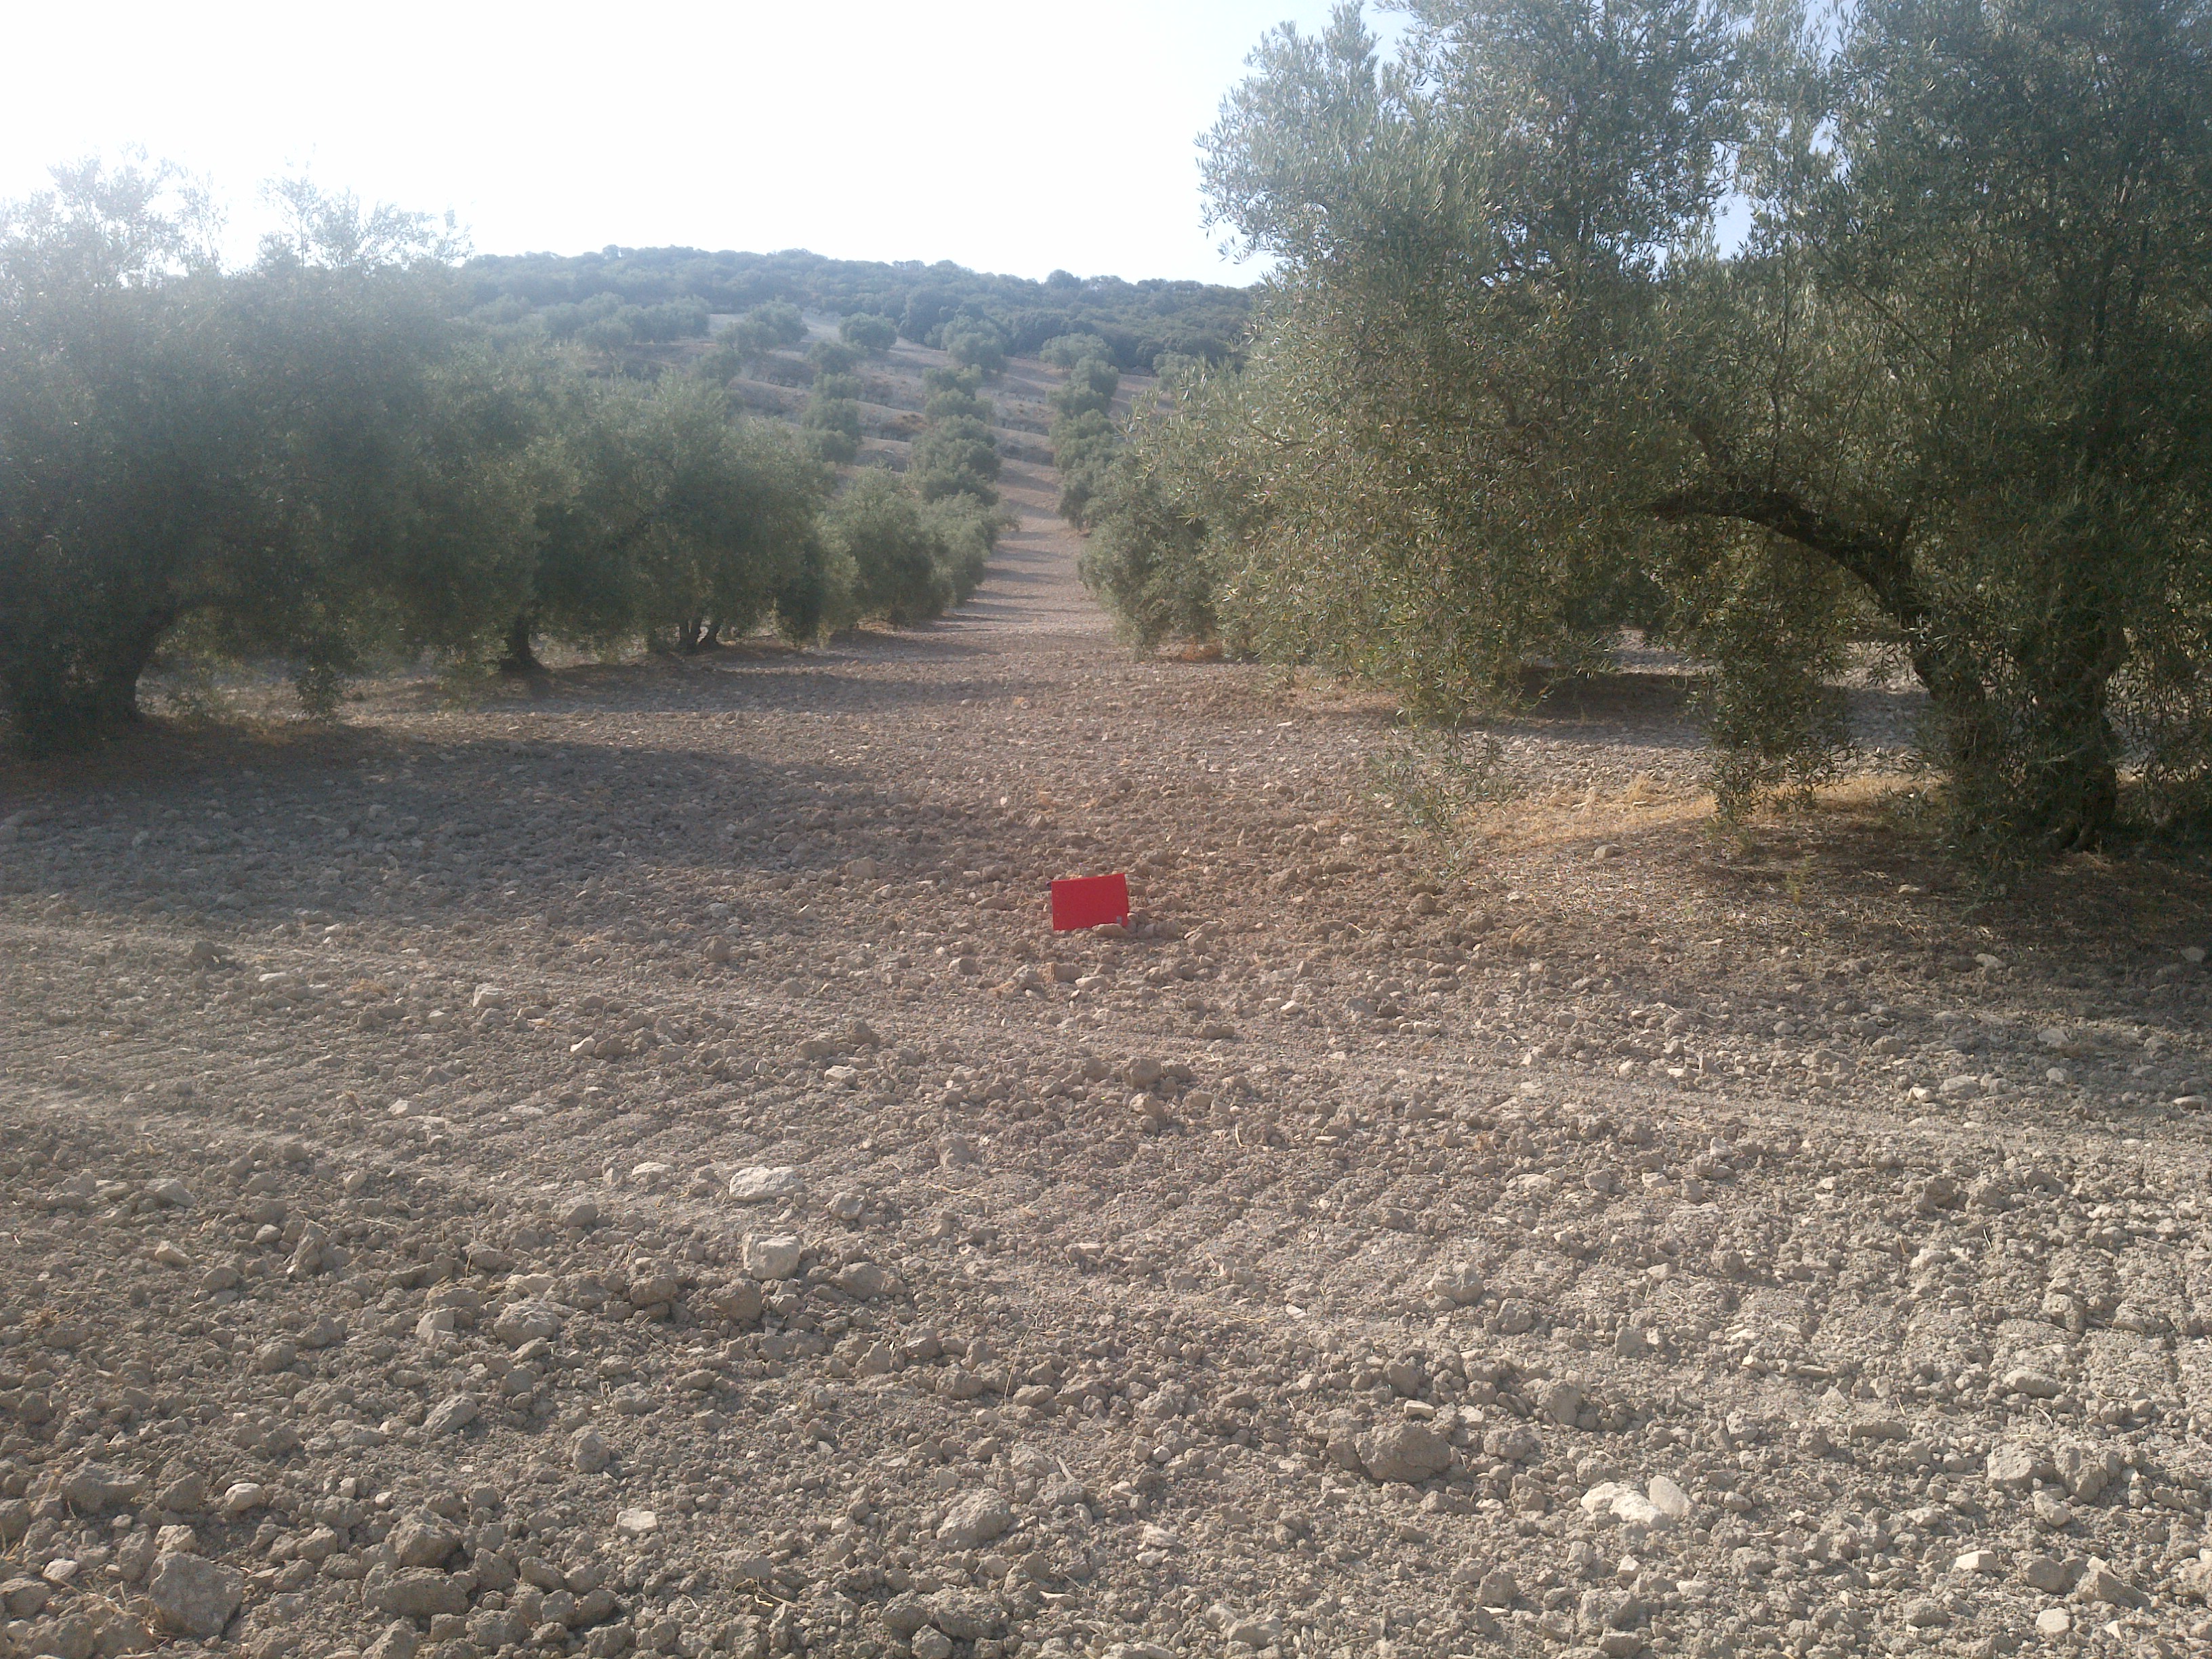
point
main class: Cropland
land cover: Olive groves
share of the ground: 50 - 75 %
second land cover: Other bare soil
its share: > 75 %
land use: Agriculture (excluding fallow land and kitchen gardens)
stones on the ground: < 10 %
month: June
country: ES
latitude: 37.6570
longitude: -4.2754
